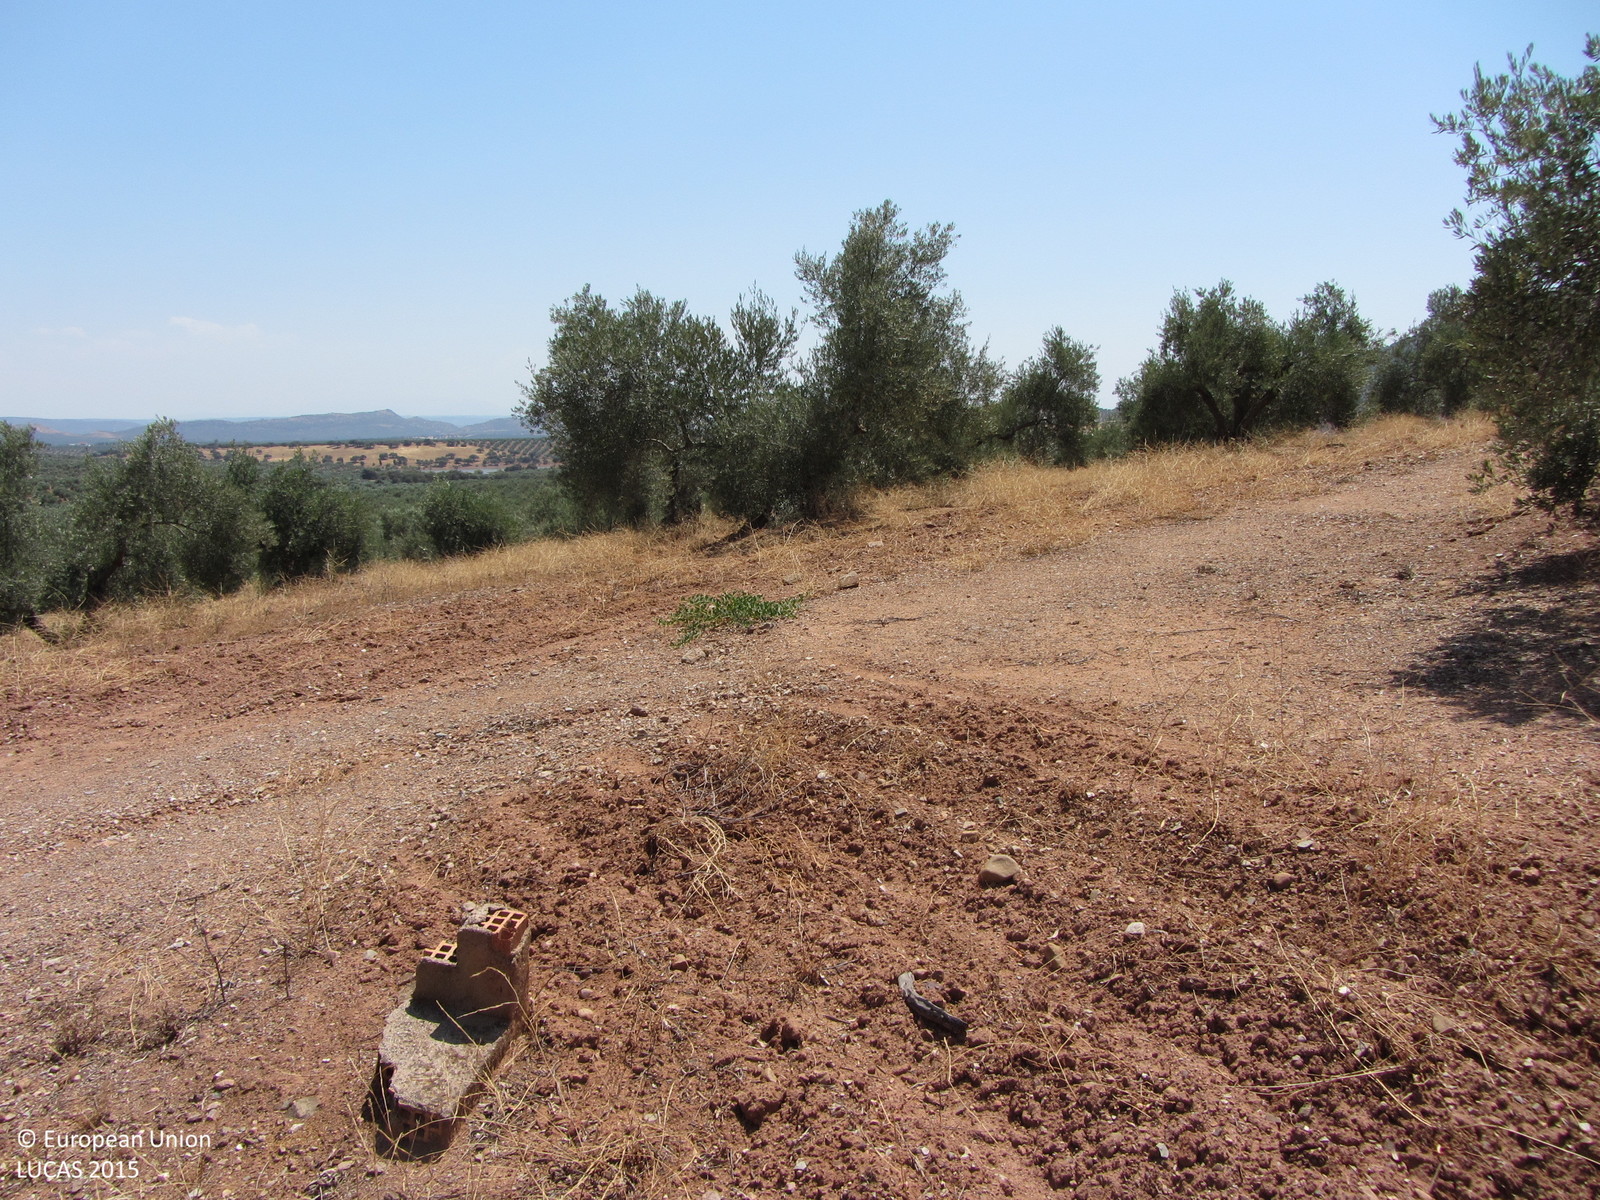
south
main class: Cropland
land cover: Olive groves
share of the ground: 25 - 50 %
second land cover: Other bare soil
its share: > 75 %
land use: Agriculture (excluding fallow land and kitchen gardens)
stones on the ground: 10 - 25 %
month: June
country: ES
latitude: 38.2367
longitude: -3.4512
